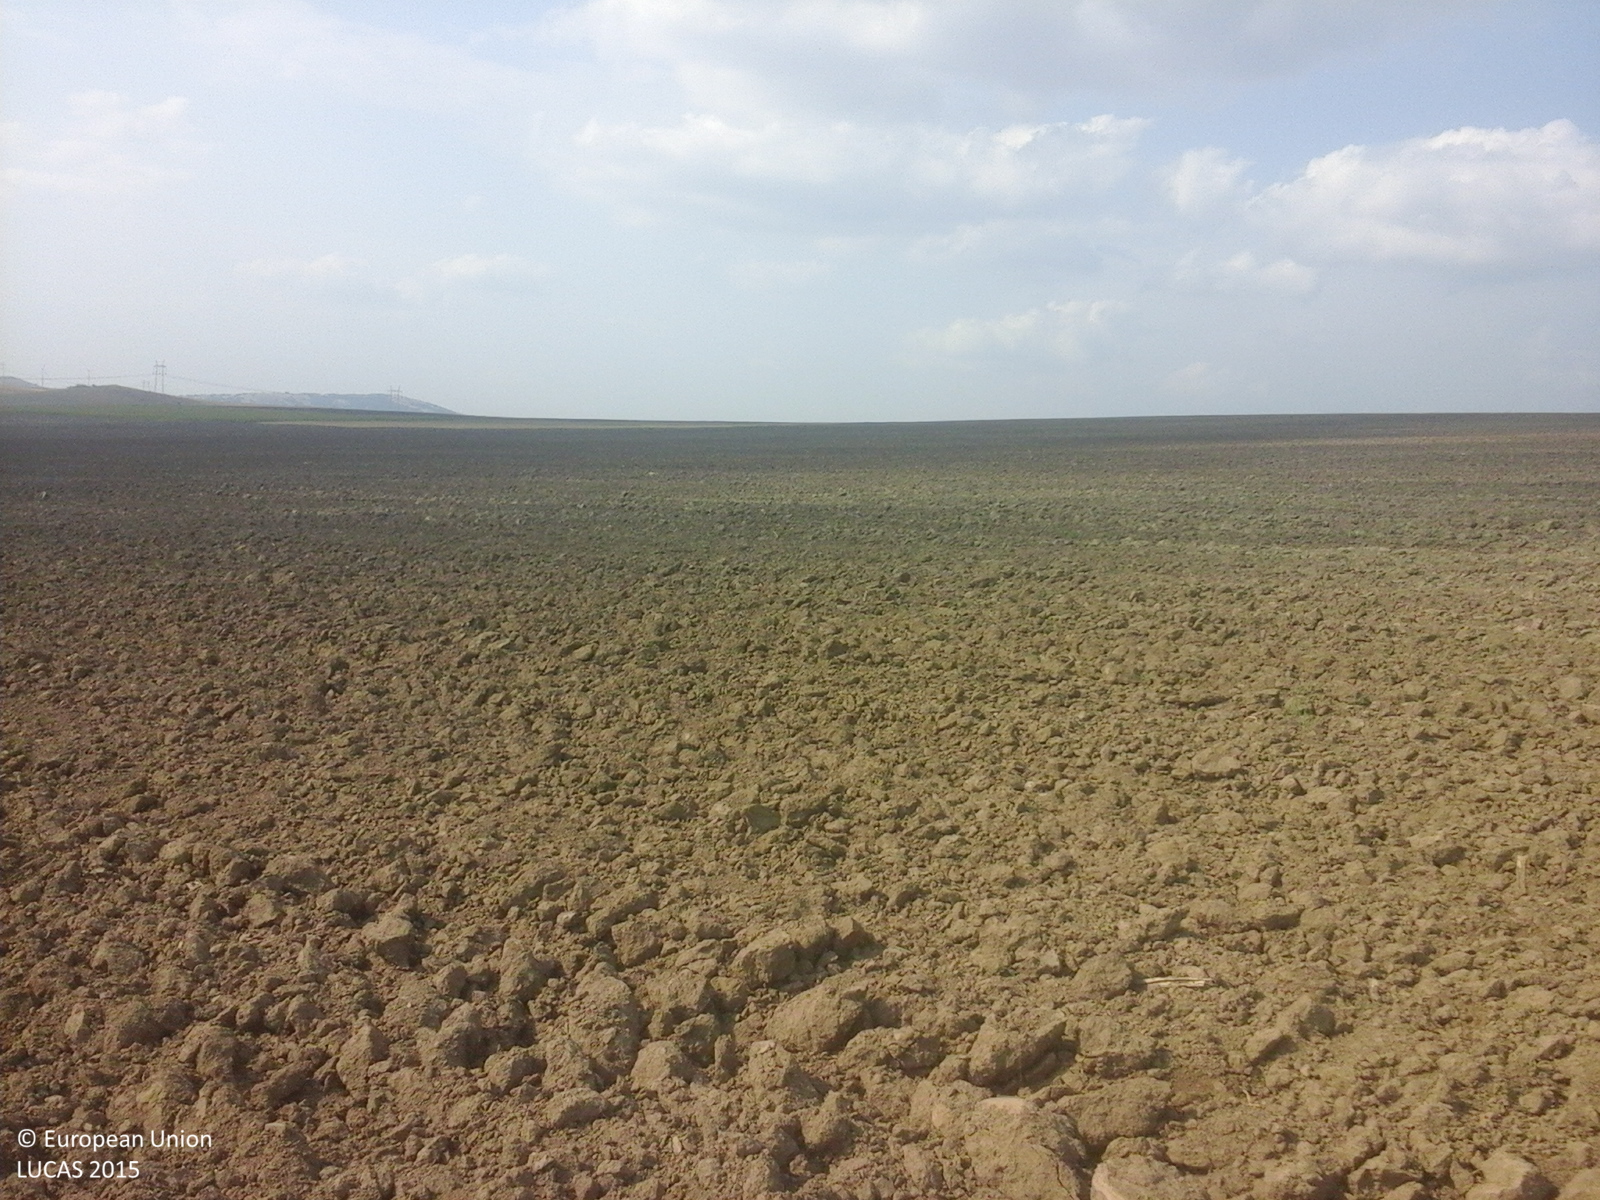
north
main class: Cropland
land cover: Common wheat
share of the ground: < 10 %
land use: Agriculture (excluding fallow land and kitchen gardens)
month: July
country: RO
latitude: 45.0164
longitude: 28.3854
